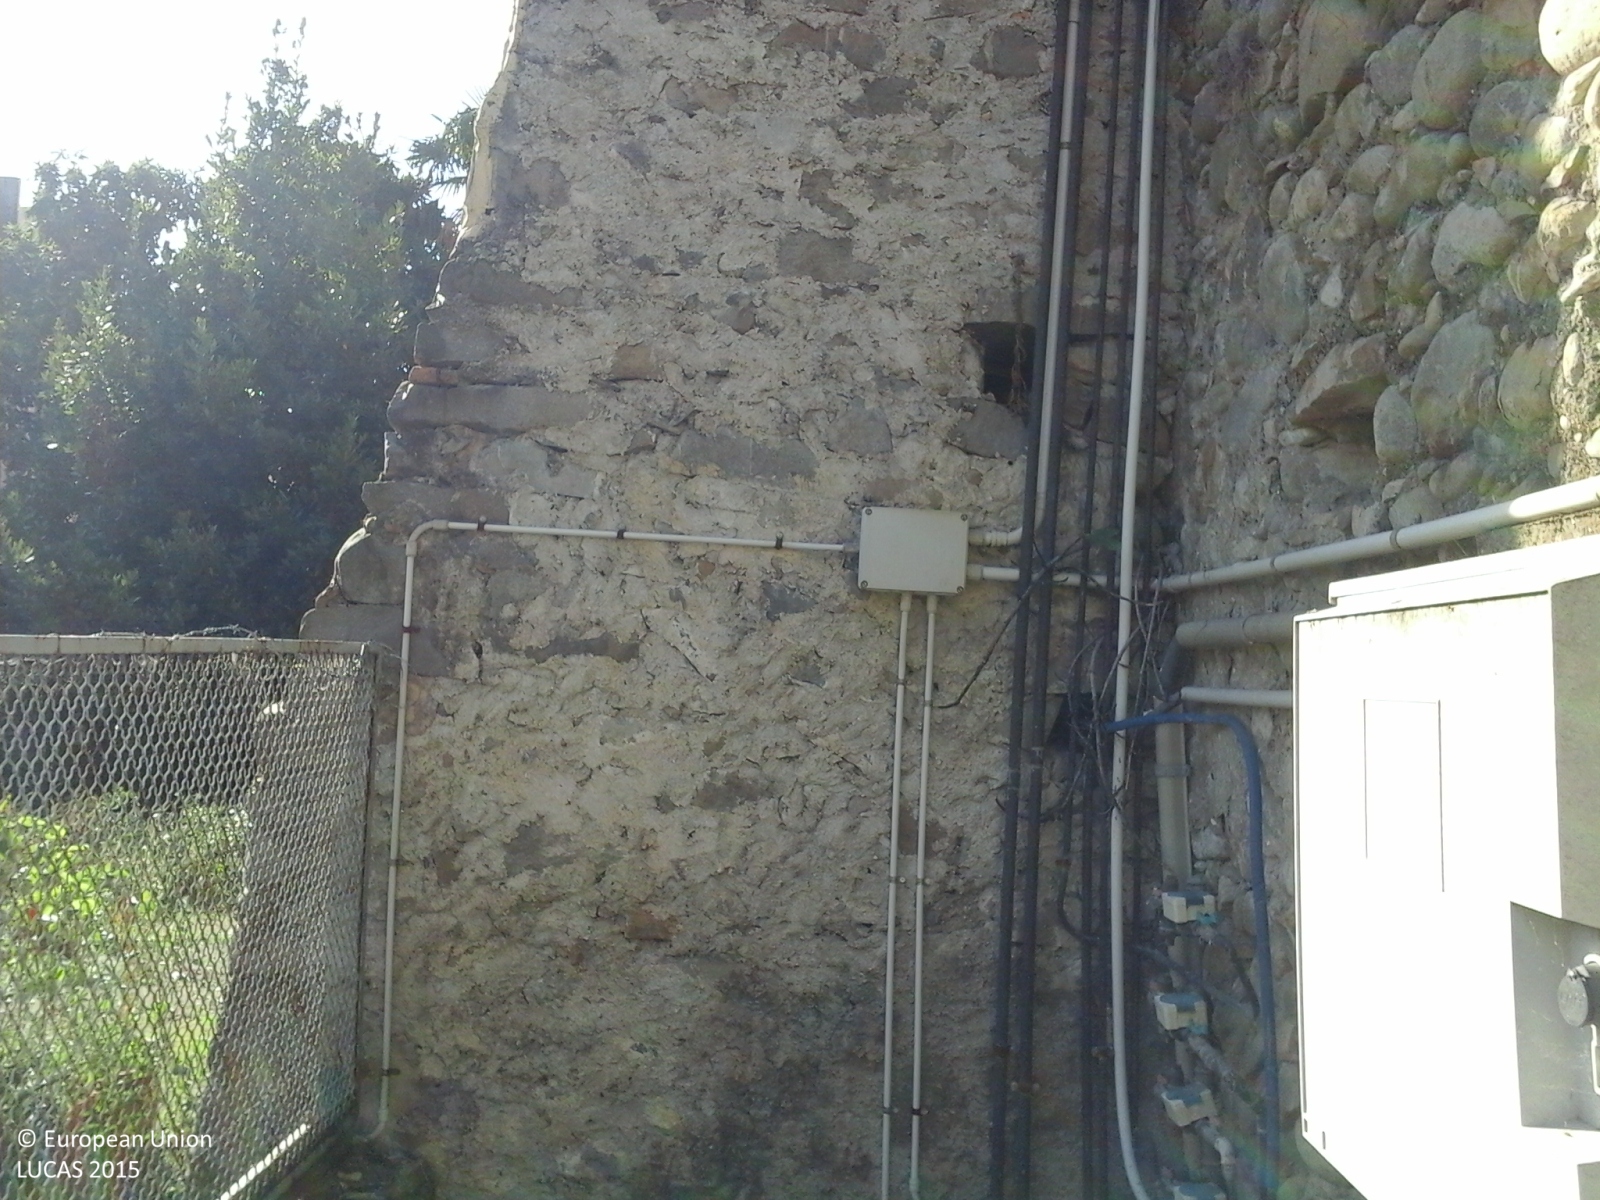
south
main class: Cropland
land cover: Other citrus fruit
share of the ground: 50 - 75 %
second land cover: Grassland without tree/shrub cover
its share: 50 - 75 %
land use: Kitchen garden
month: October
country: IT
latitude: 43.8592
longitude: 7.8529
